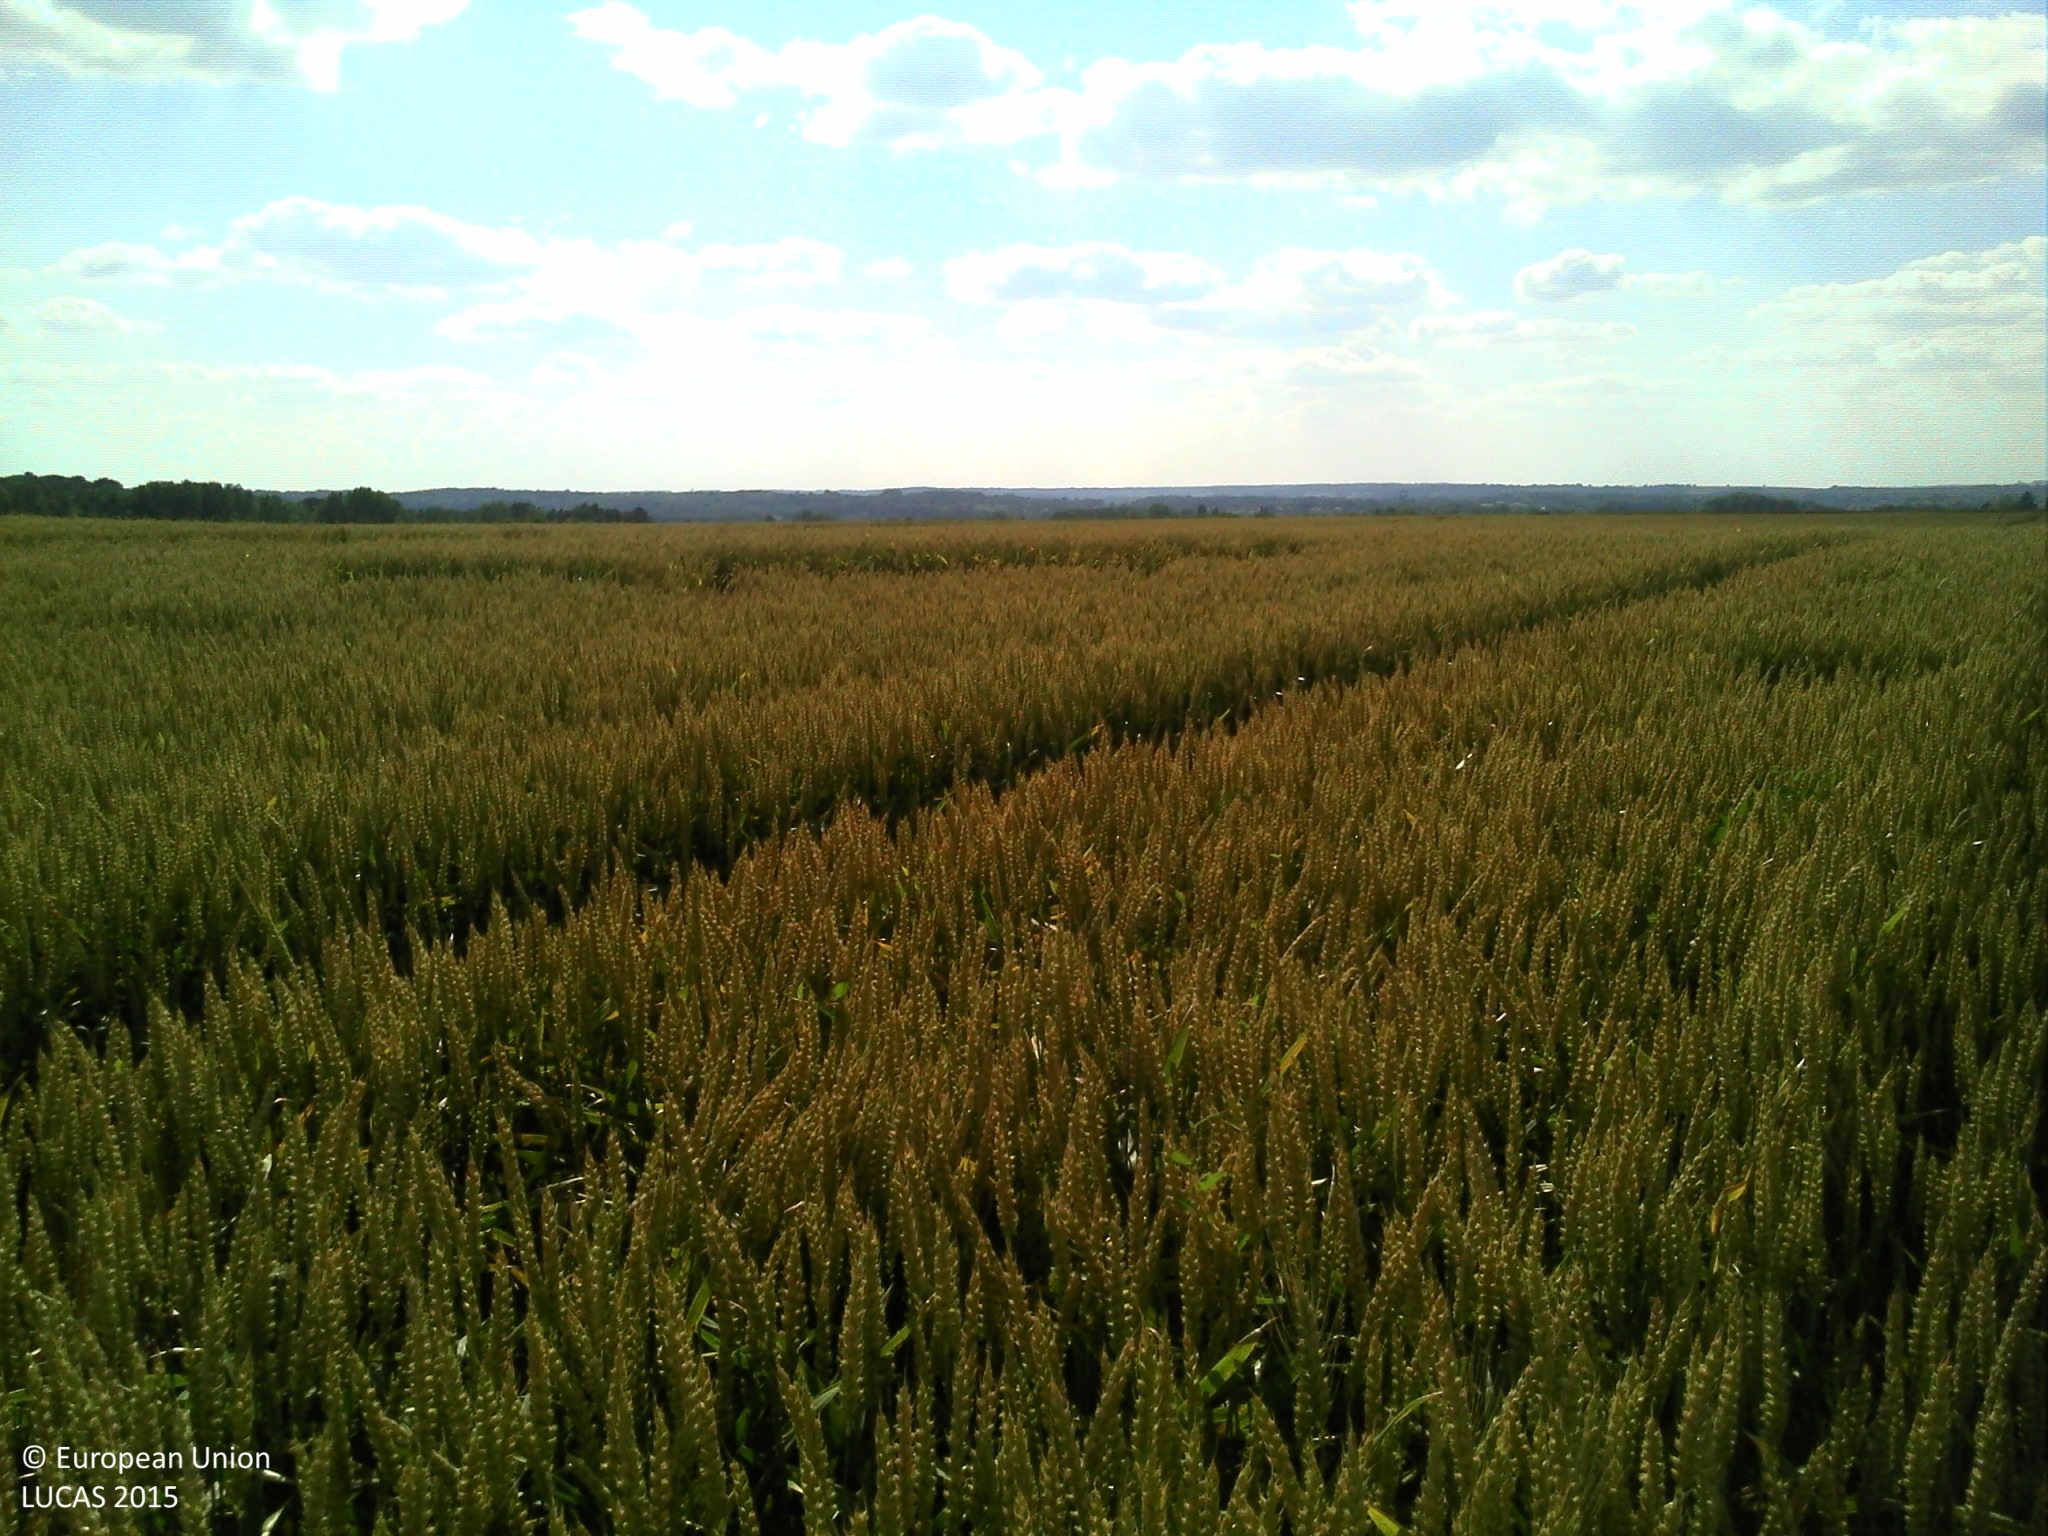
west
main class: Cropland
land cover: Common wheat
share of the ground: > 75 %
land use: Agriculture (excluding fallow land and kitchen gardens)
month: June
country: FR
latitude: 46.7495
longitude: 0.5703
